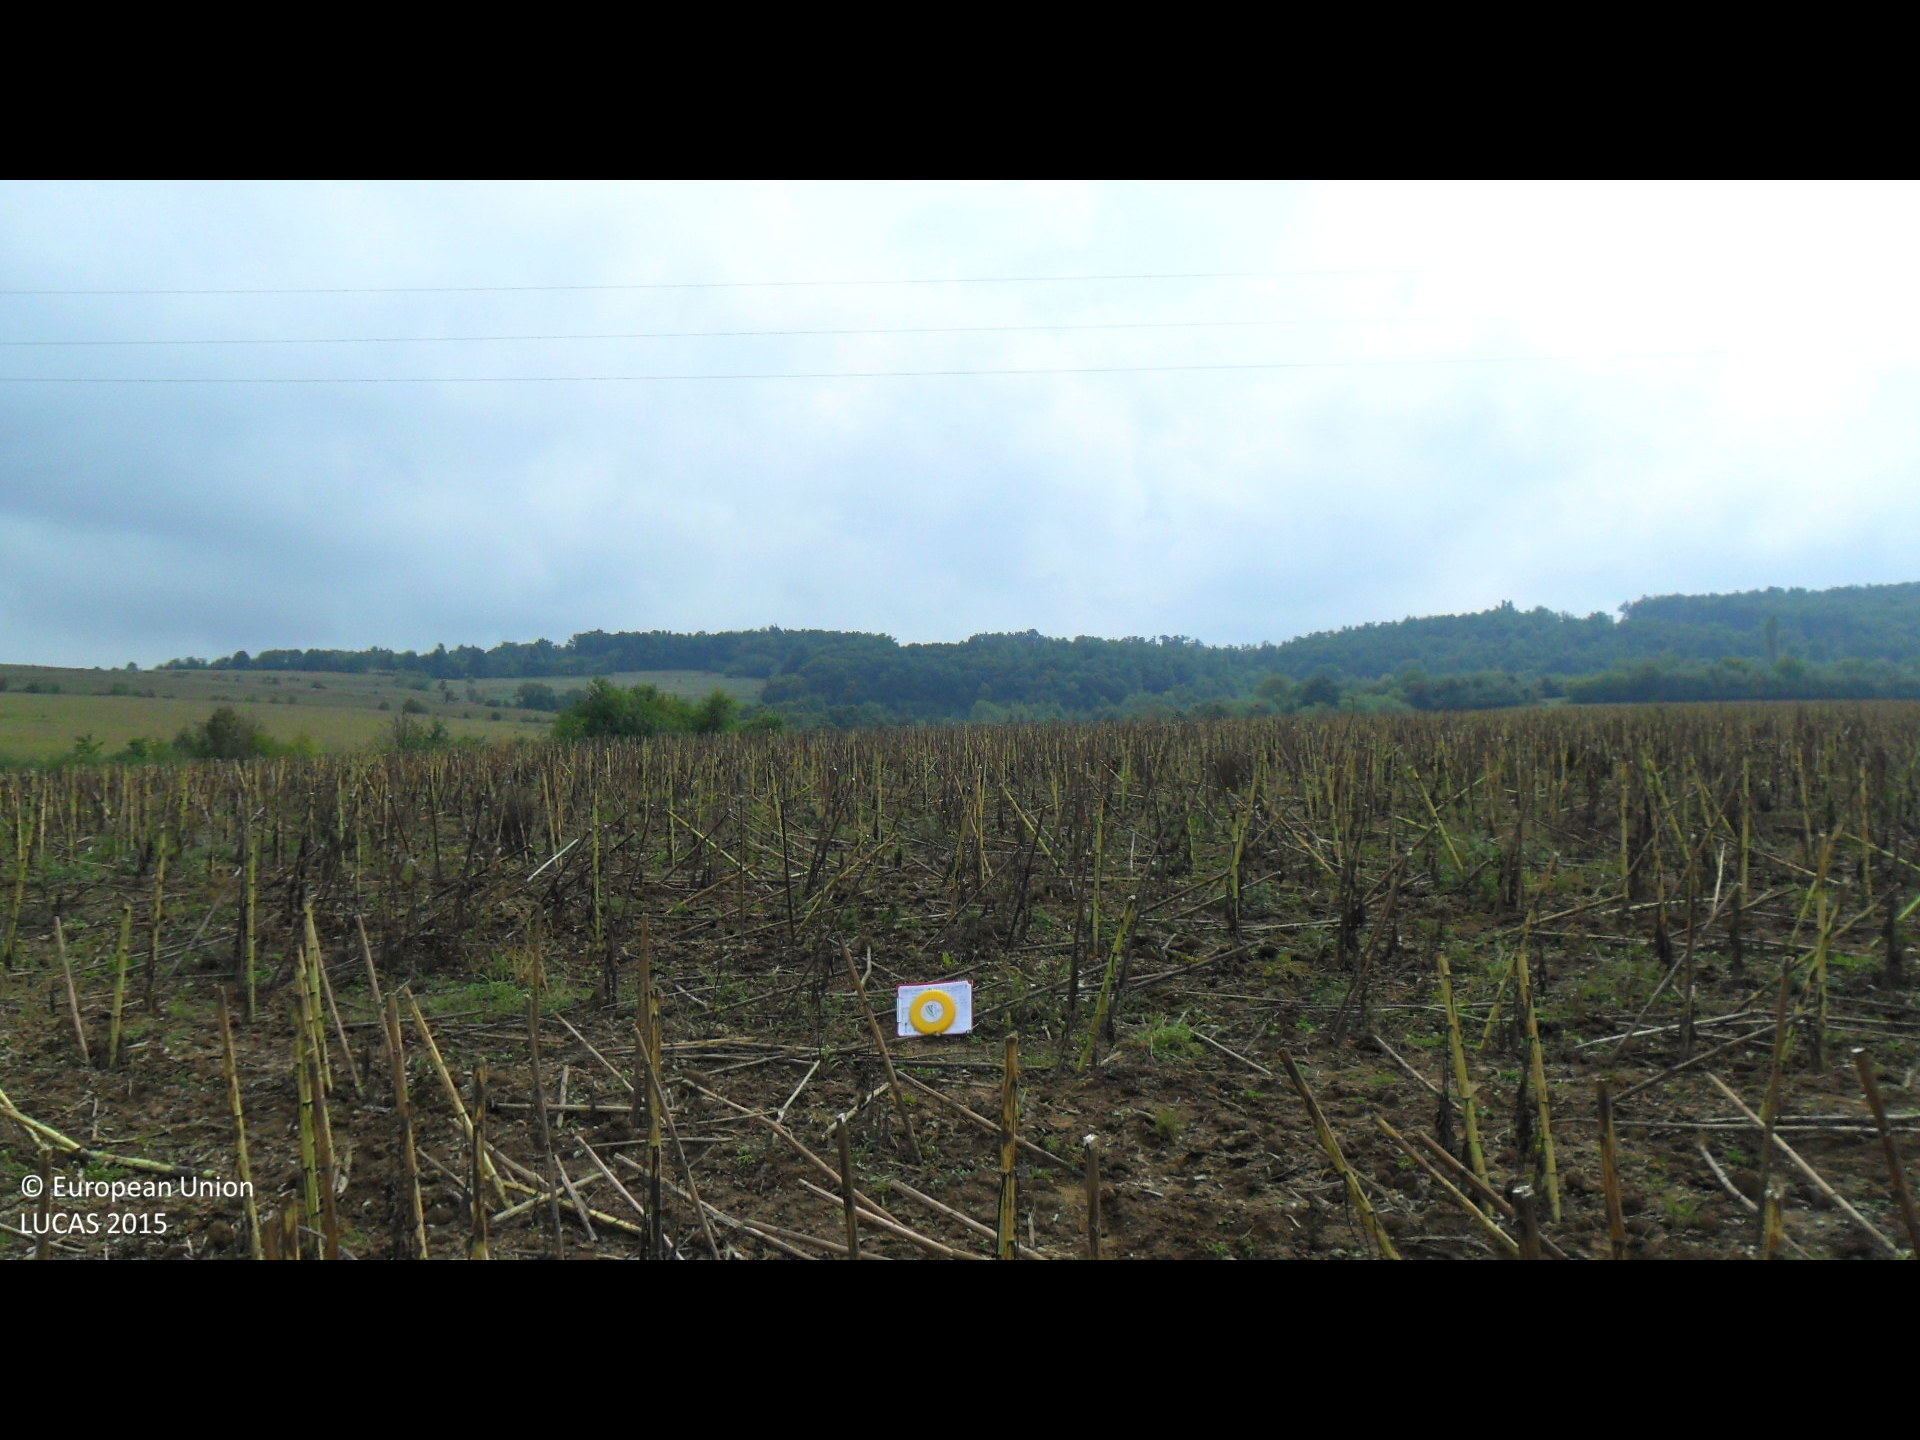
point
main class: Cropland
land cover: Sunflower
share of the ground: 50 - 75 %
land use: Agriculture (excluding fallow land and kitchen gardens)
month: September
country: BG
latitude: 43.0668
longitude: 26.3170
